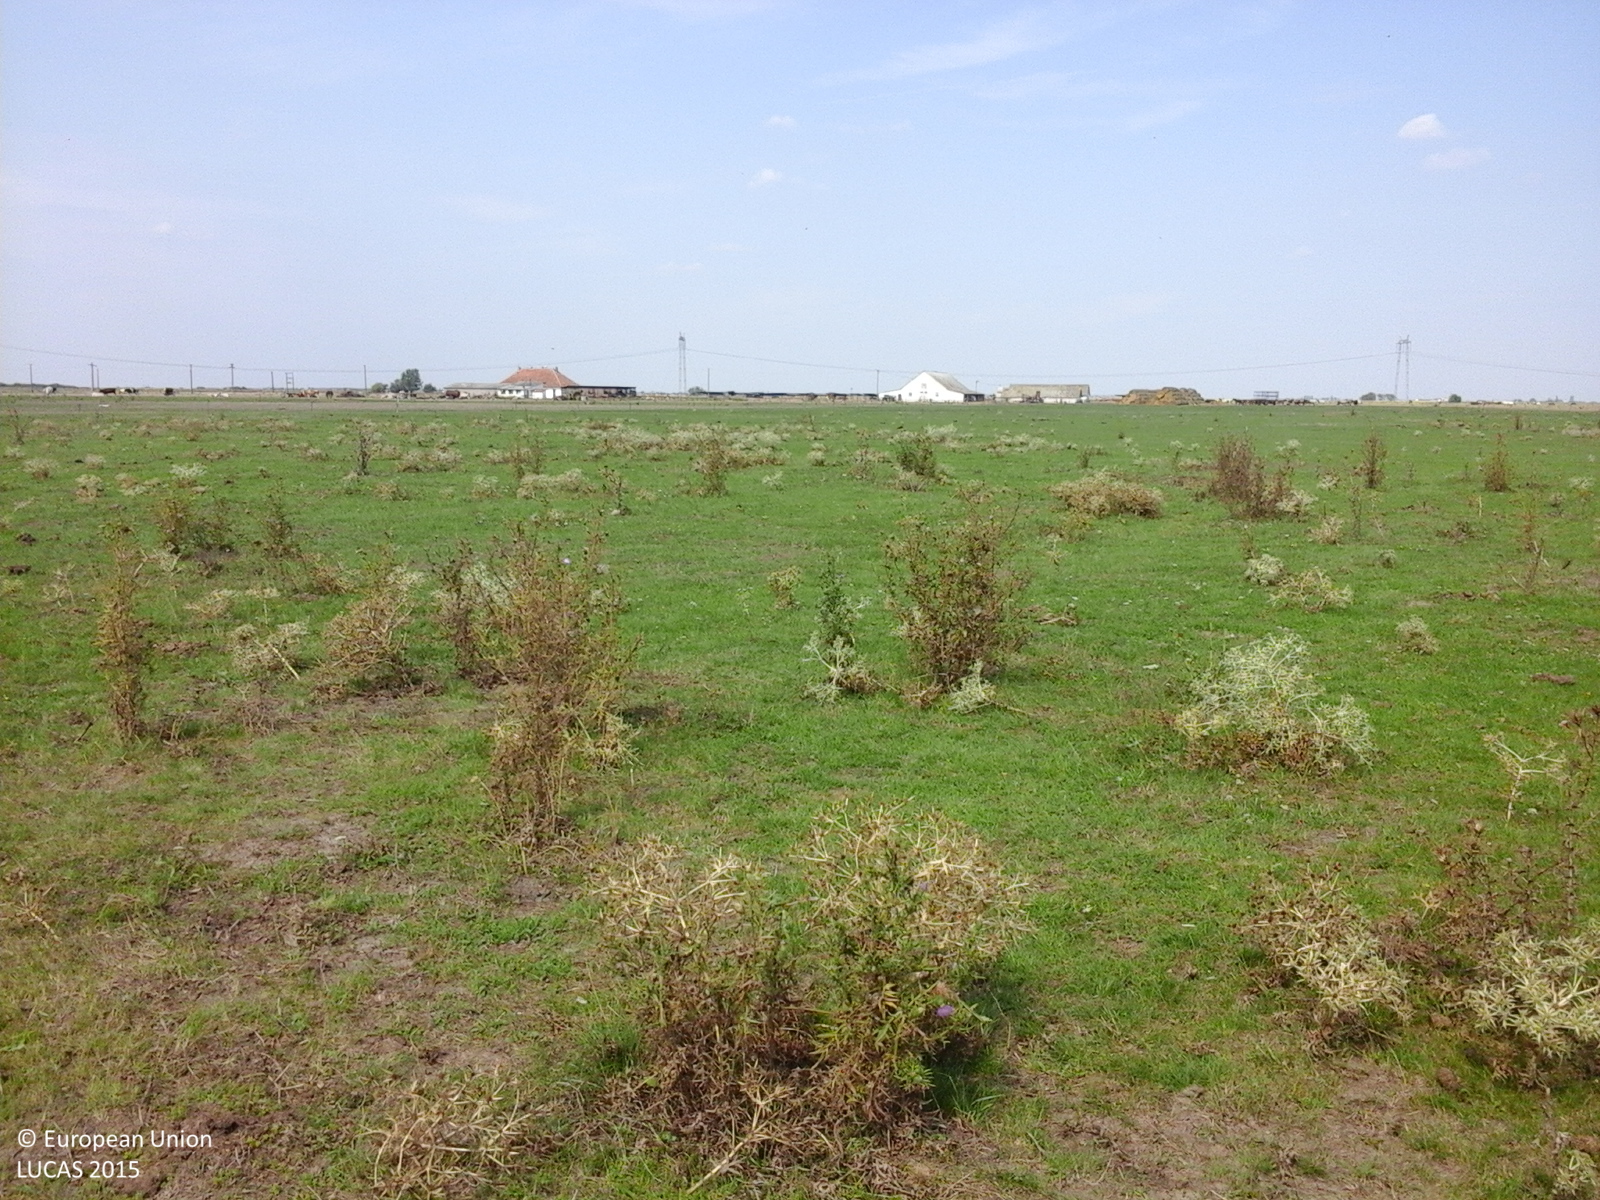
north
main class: Grassland
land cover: Grassland without tree/shrub cover
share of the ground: > 75 %
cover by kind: herbaceous plants 100 %
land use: Agriculture (excluding fallow land and kitchen gardens)
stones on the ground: < 10 %
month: August
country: RO
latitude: 46.2366
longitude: 21.1718
